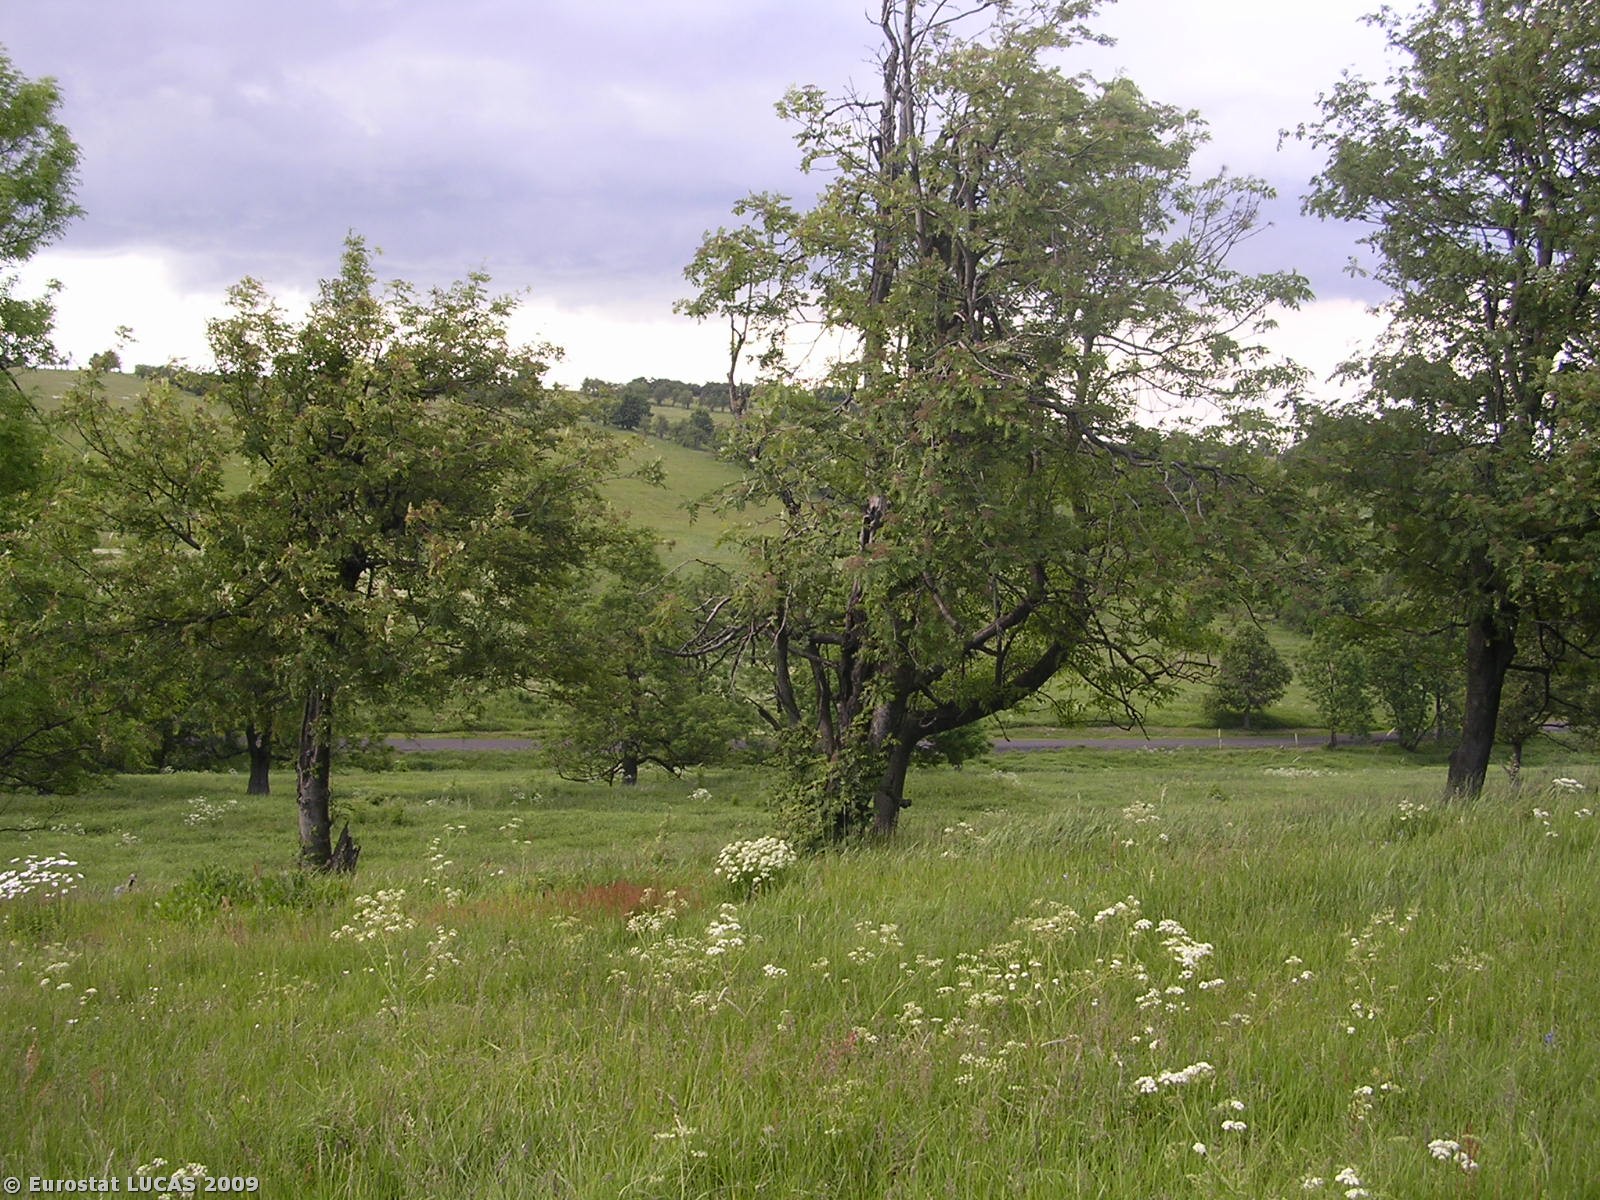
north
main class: Grassland
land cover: Grassland without tree/shrub cover
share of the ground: > 75 %
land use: Agriculture (excluding fallow land and kitchen gardens)
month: June
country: CZ
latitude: 50.7448
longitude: 13.9833
